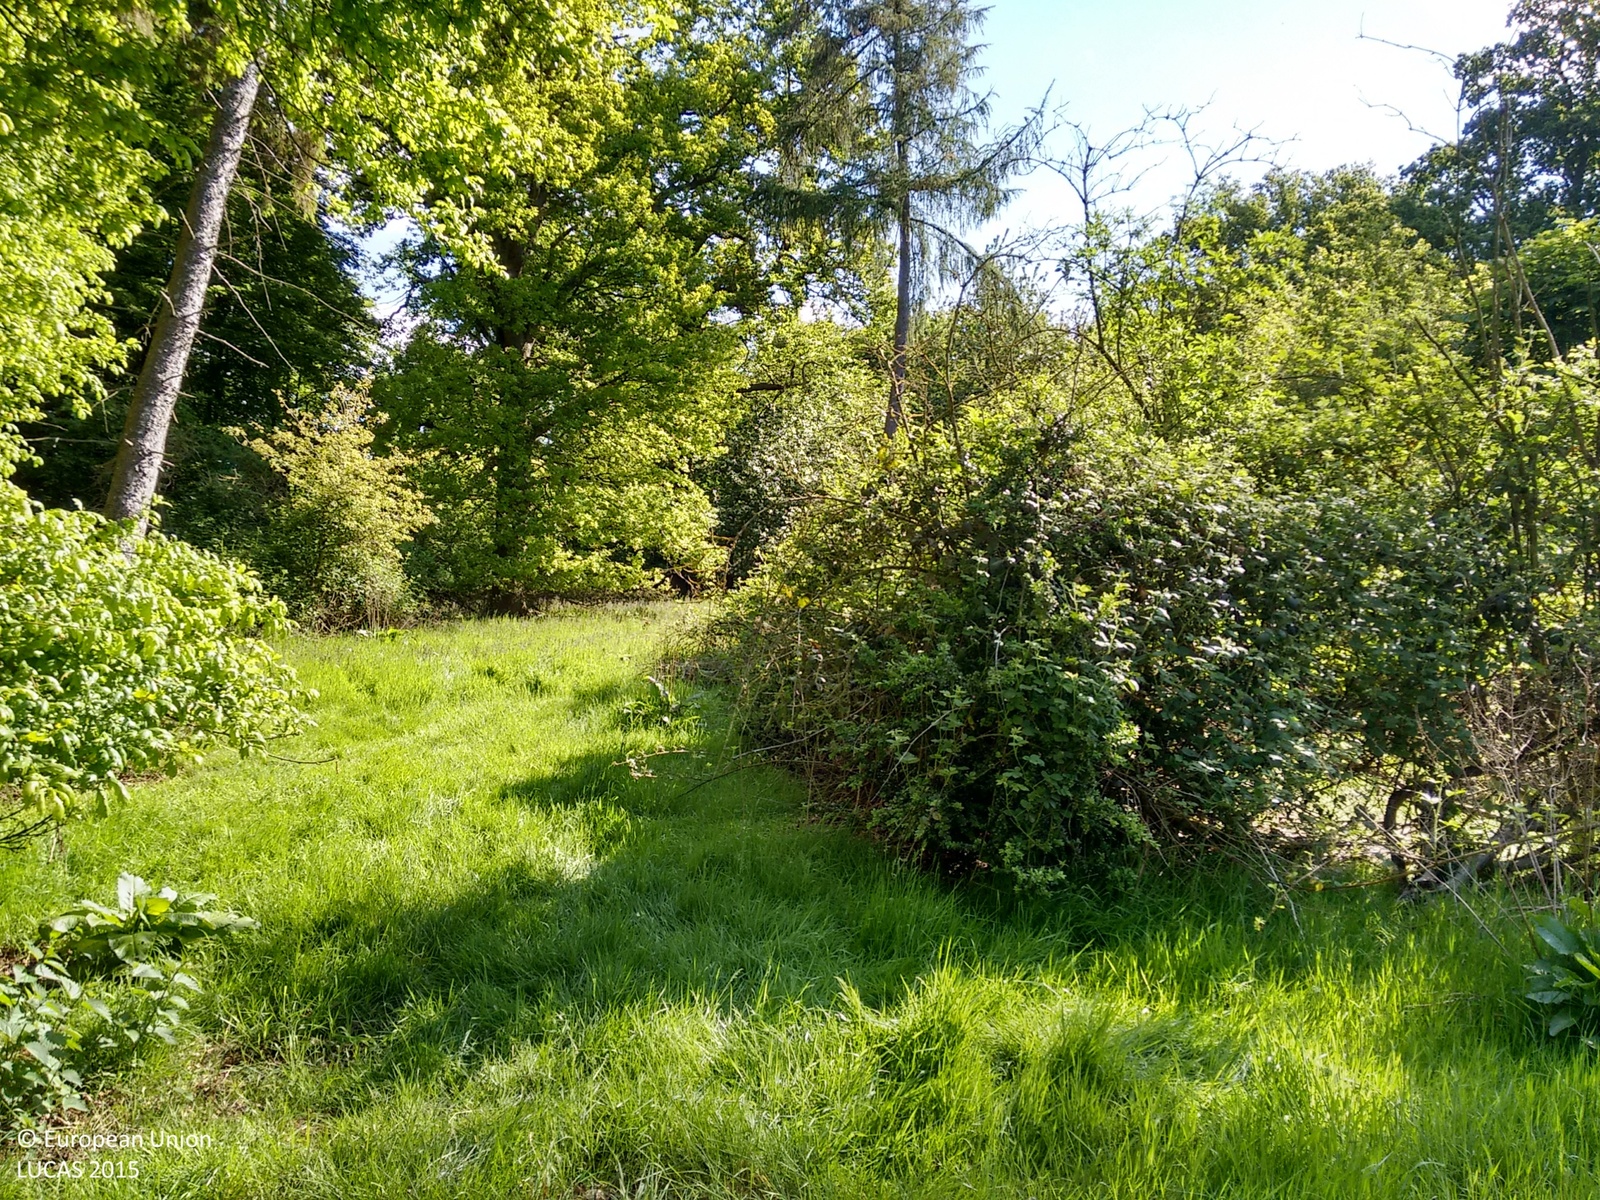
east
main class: Woodland
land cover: Other mixed woodland
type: hemiboreal forest and nemoral coniferous forest and mixed broadleaved-coniferous forest
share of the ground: > 75 %
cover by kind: broadleaved forest trees 60 %, coniferous forest trees 30 %, herbaceous plants 10 %
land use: Forestry
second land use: Agriculture (excluding fallow land and kitchen gardens)
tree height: > 5 m
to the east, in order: Other mixed woodland; Fences; Tracks; Broadleaved woodland; Tracks; Other leguminous and mixtures for fodder; Barley
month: May
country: GB
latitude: 51.8937
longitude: -0.2804
